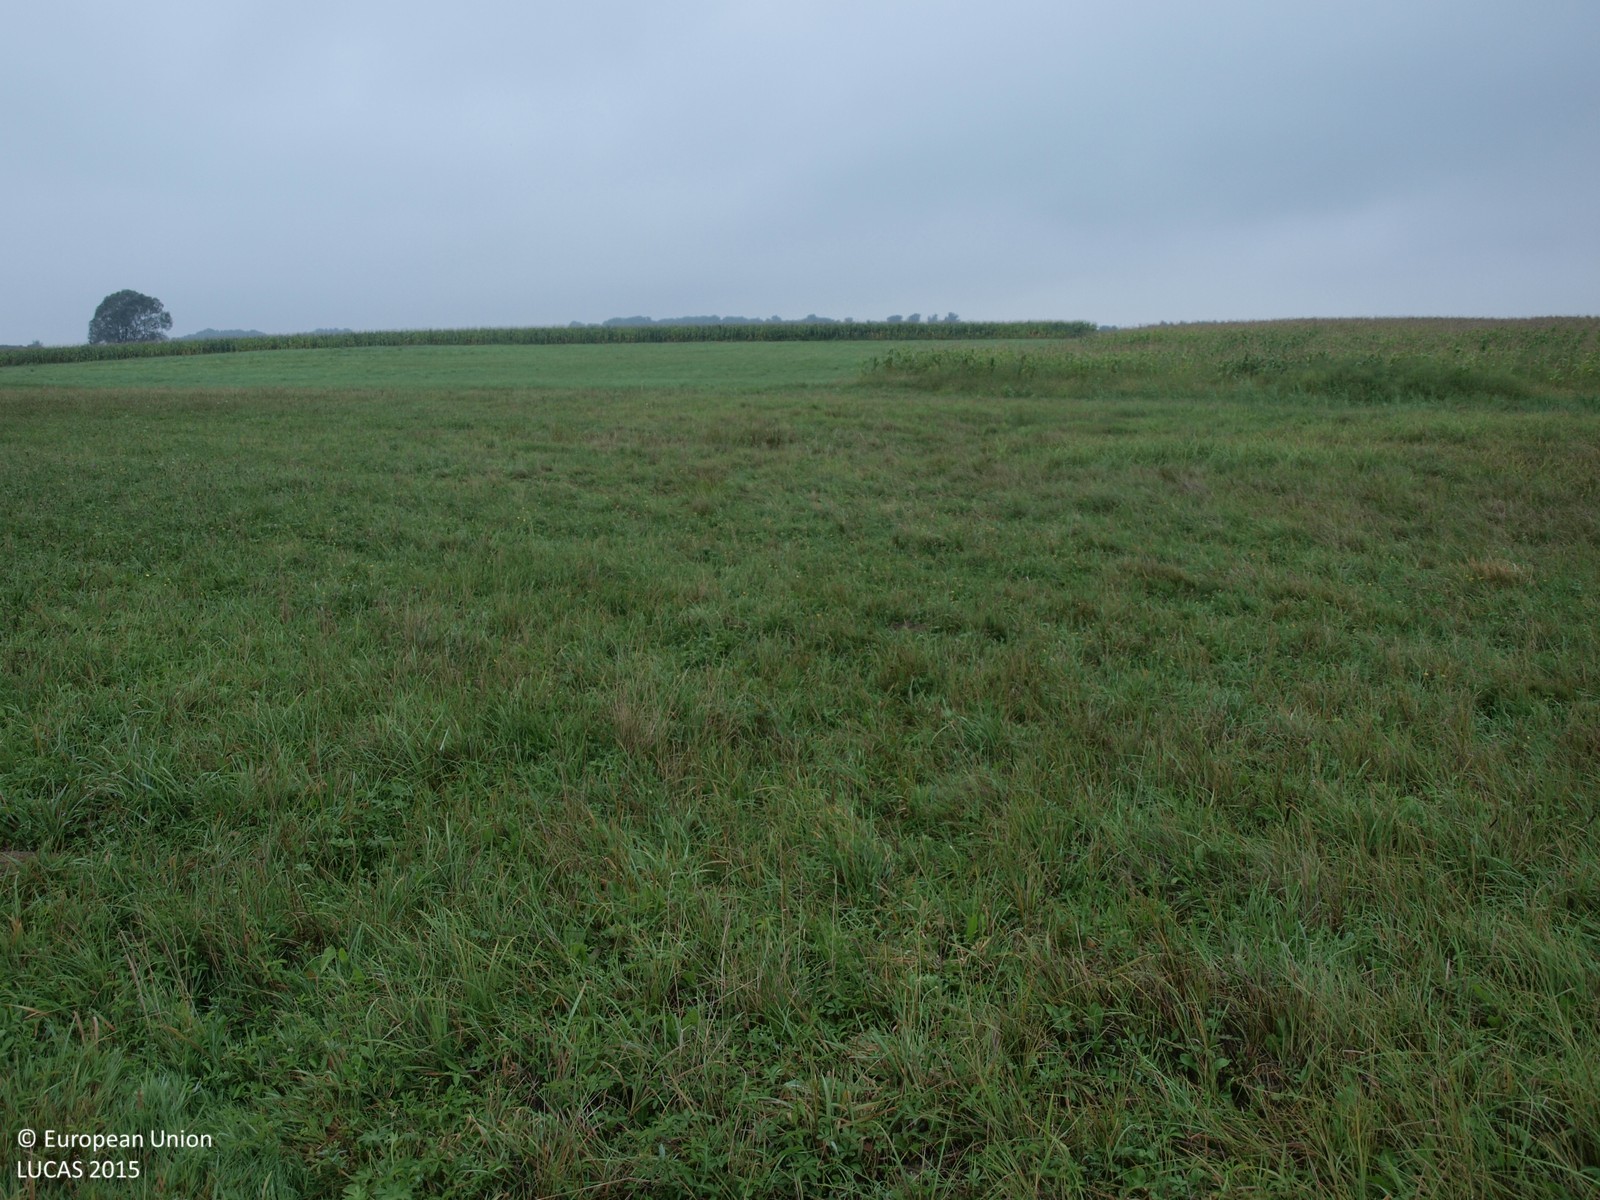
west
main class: Grassland
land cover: Grassland without tree/shrub cover
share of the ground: > 75 %
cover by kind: herbaceous plants 100 %
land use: Agriculture (excluding fallow land and kitchen gardens)
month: August
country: HR
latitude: 45.8047
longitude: 16.2907
